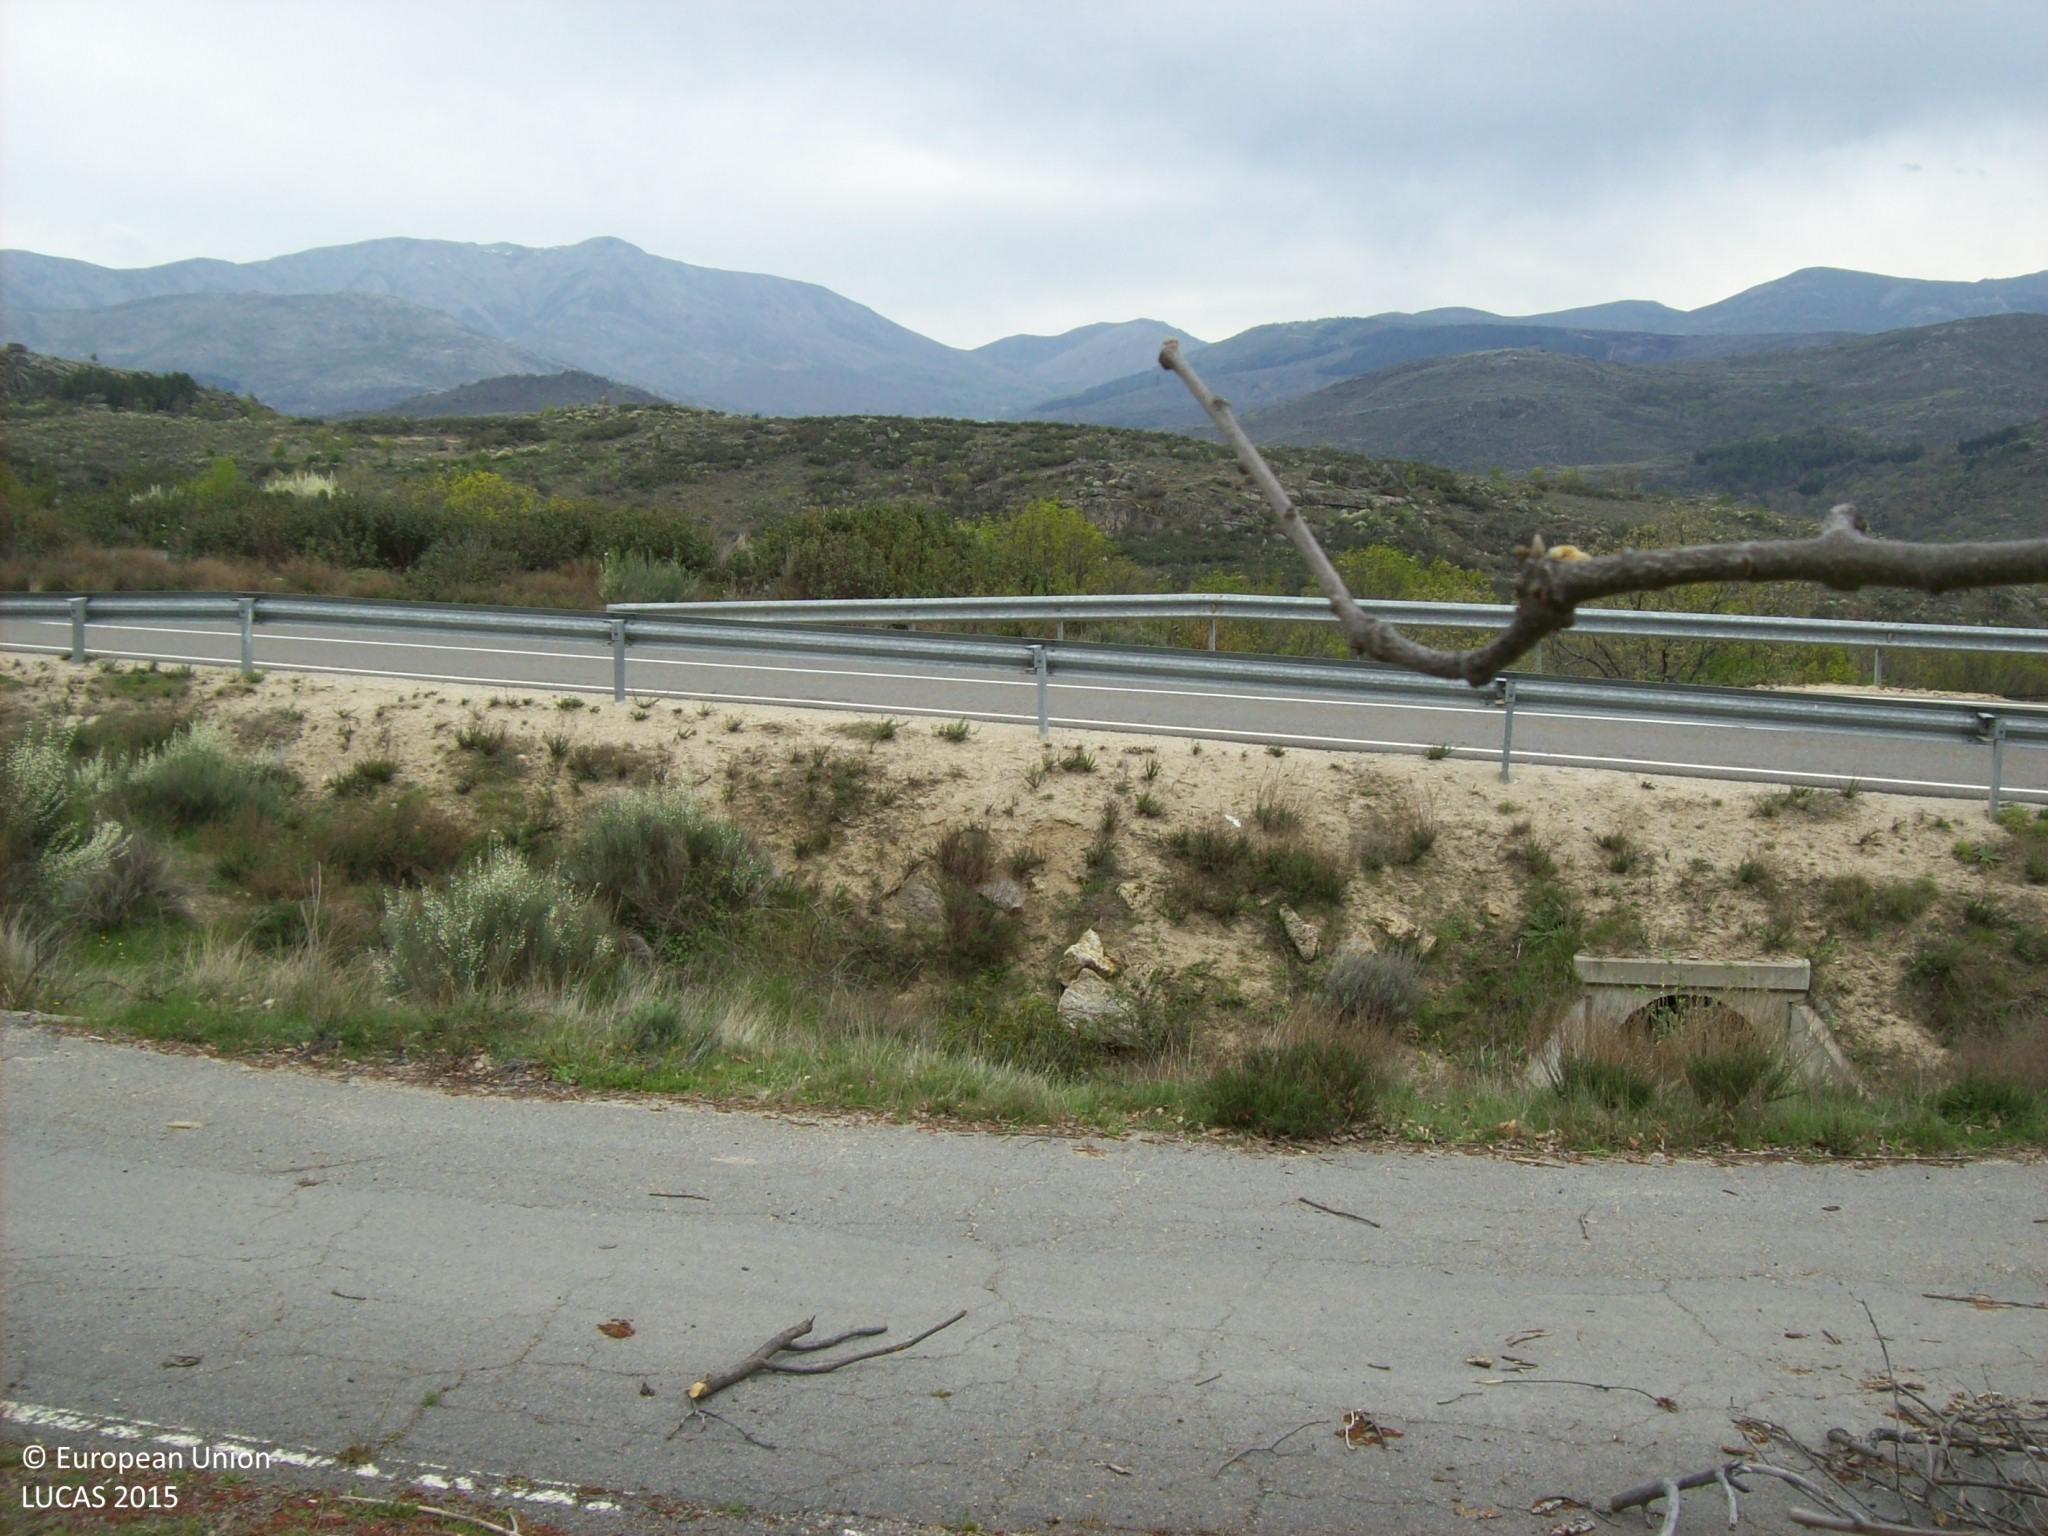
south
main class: Woodland
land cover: Broadleaved woodland
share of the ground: 10 - 25 %
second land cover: Grassland without tree/shrub cover
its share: > 75 %
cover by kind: herbaceous plants 75 %, broadleaved forest trees 25 %
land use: Forestry
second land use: Agriculture (excluding fallow land and kitchen gardens)
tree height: < 5 m
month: April
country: ES
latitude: 40.4089
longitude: -4.8911
